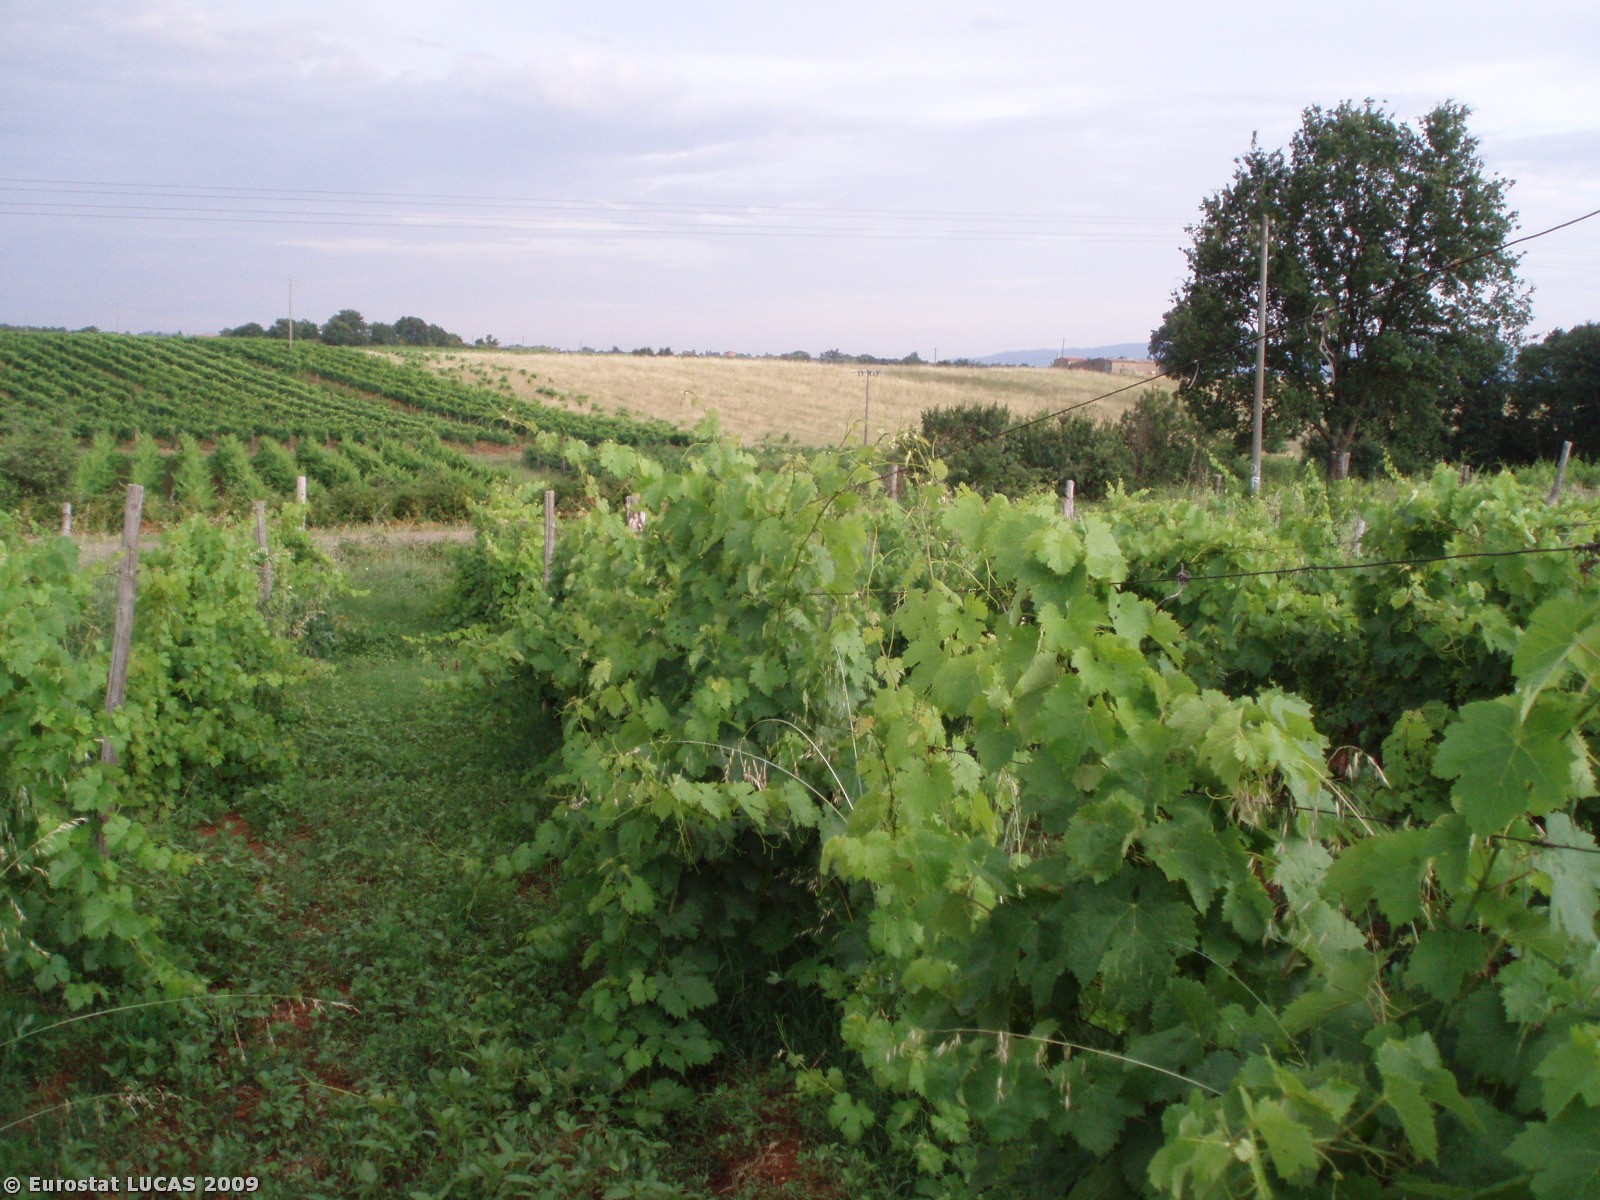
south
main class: Cropland
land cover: Vineyards
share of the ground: 50 - 75 %
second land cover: Spontaneously vegetated surfaces
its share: 50 - 75 %
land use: Agriculture (excluding fallow land and kitchen gardens)
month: June
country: IT
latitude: 42.6231
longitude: 11.6162
